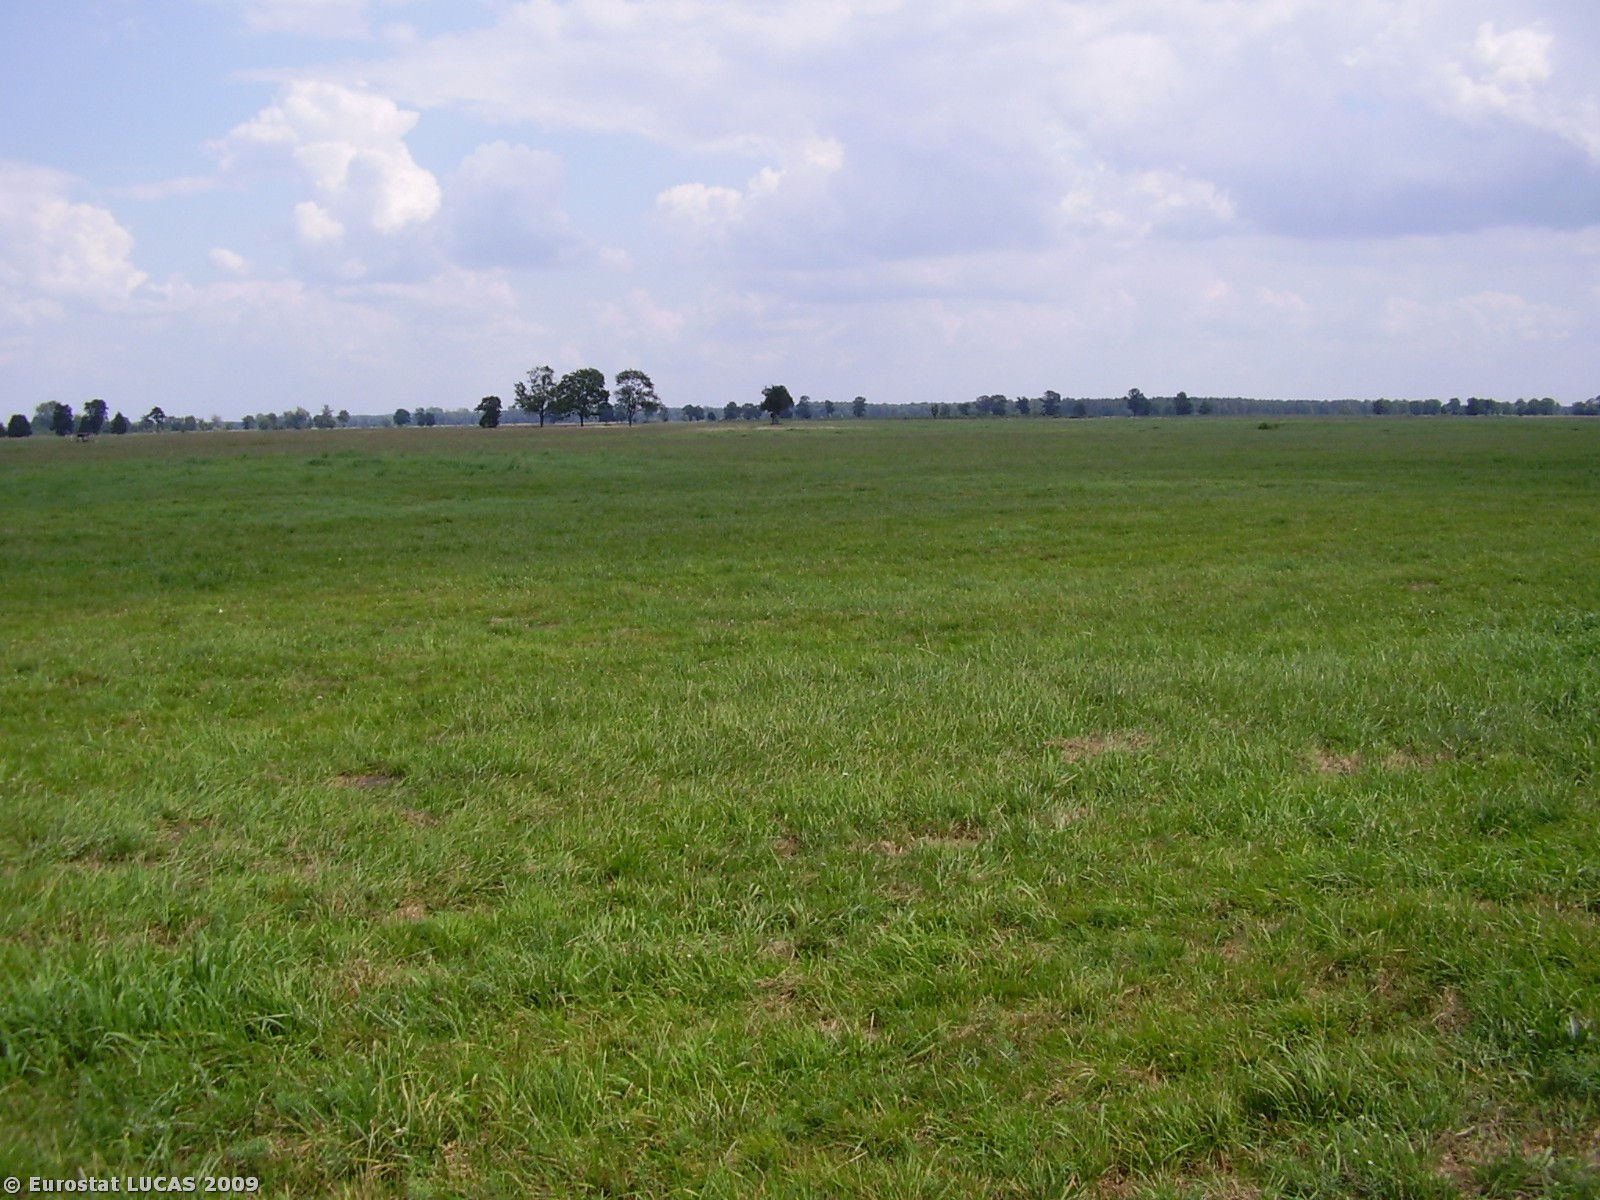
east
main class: Grassland
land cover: Grassland without tree/shrub cover
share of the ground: > 75 %
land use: Agriculture (excluding fallow land and kitchen gardens)
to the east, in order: Grassland without tree/shrub cover
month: July
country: PL
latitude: 52.0499
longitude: 16.2624
